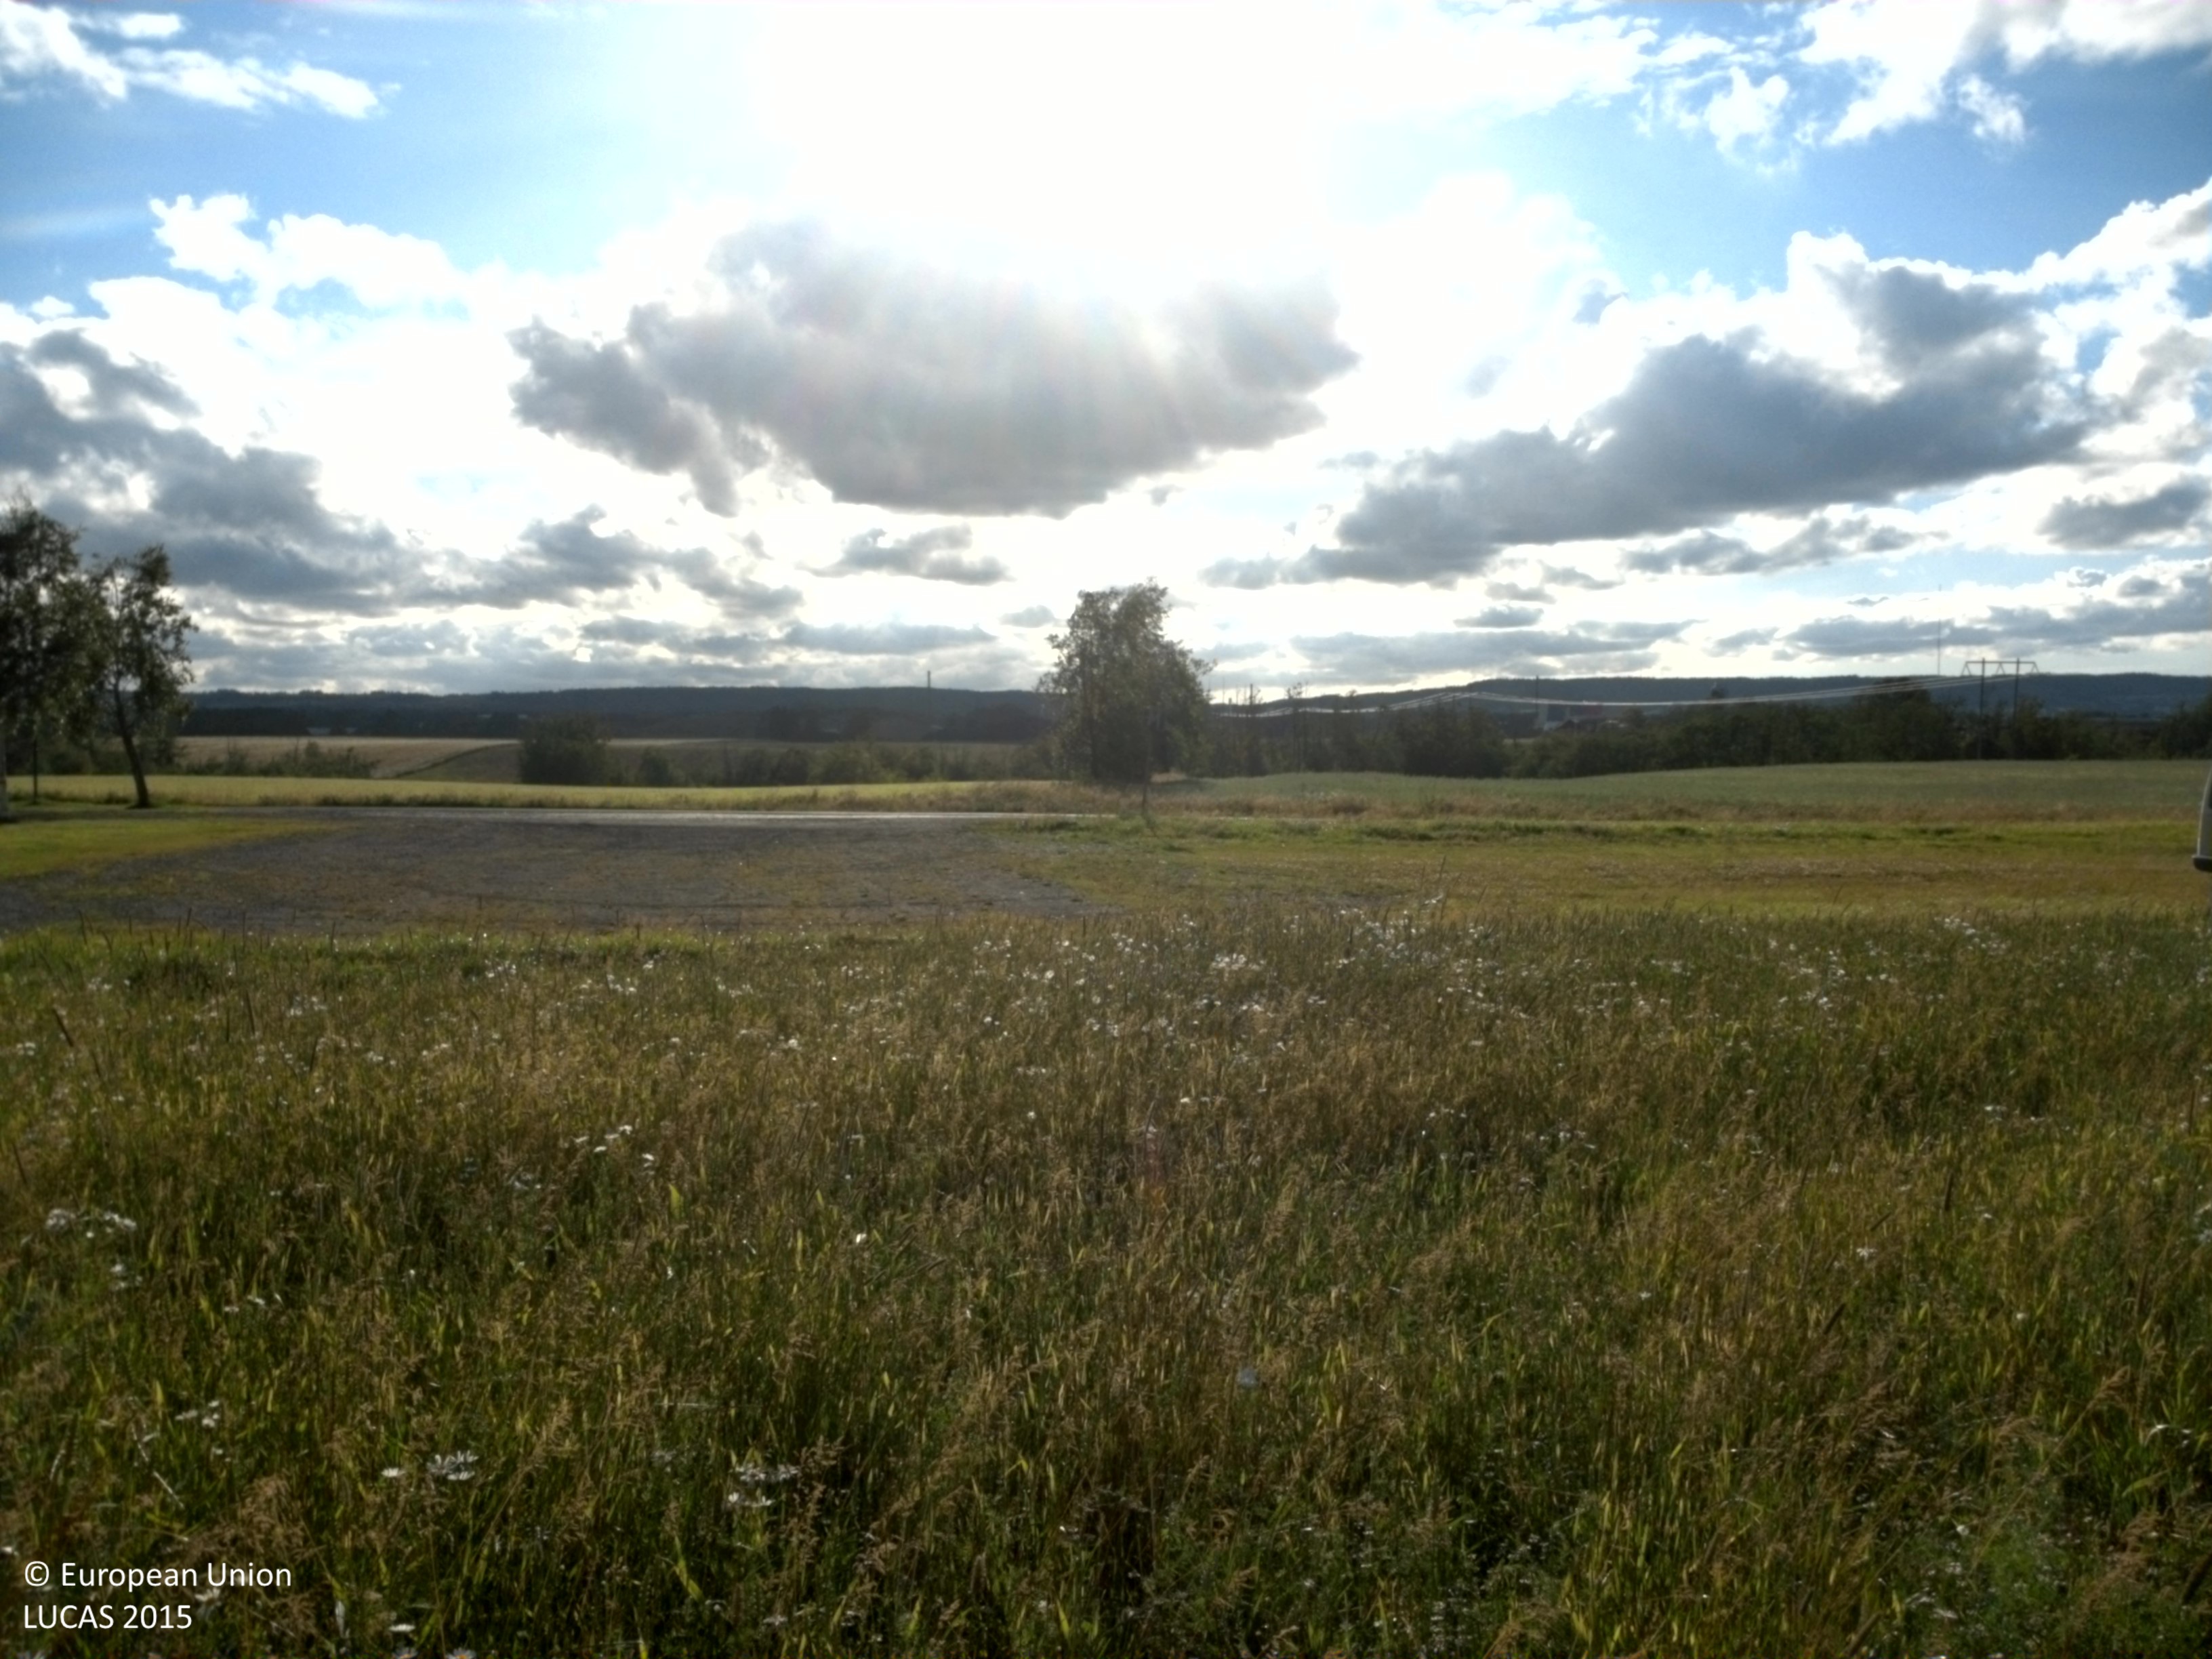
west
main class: Cropland
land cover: Common wheat
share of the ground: > 75 %
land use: Agriculture (excluding fallow land and kitchen gardens)
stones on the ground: > 50 %
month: July
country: SE
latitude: 58.3788
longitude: 13.9098
